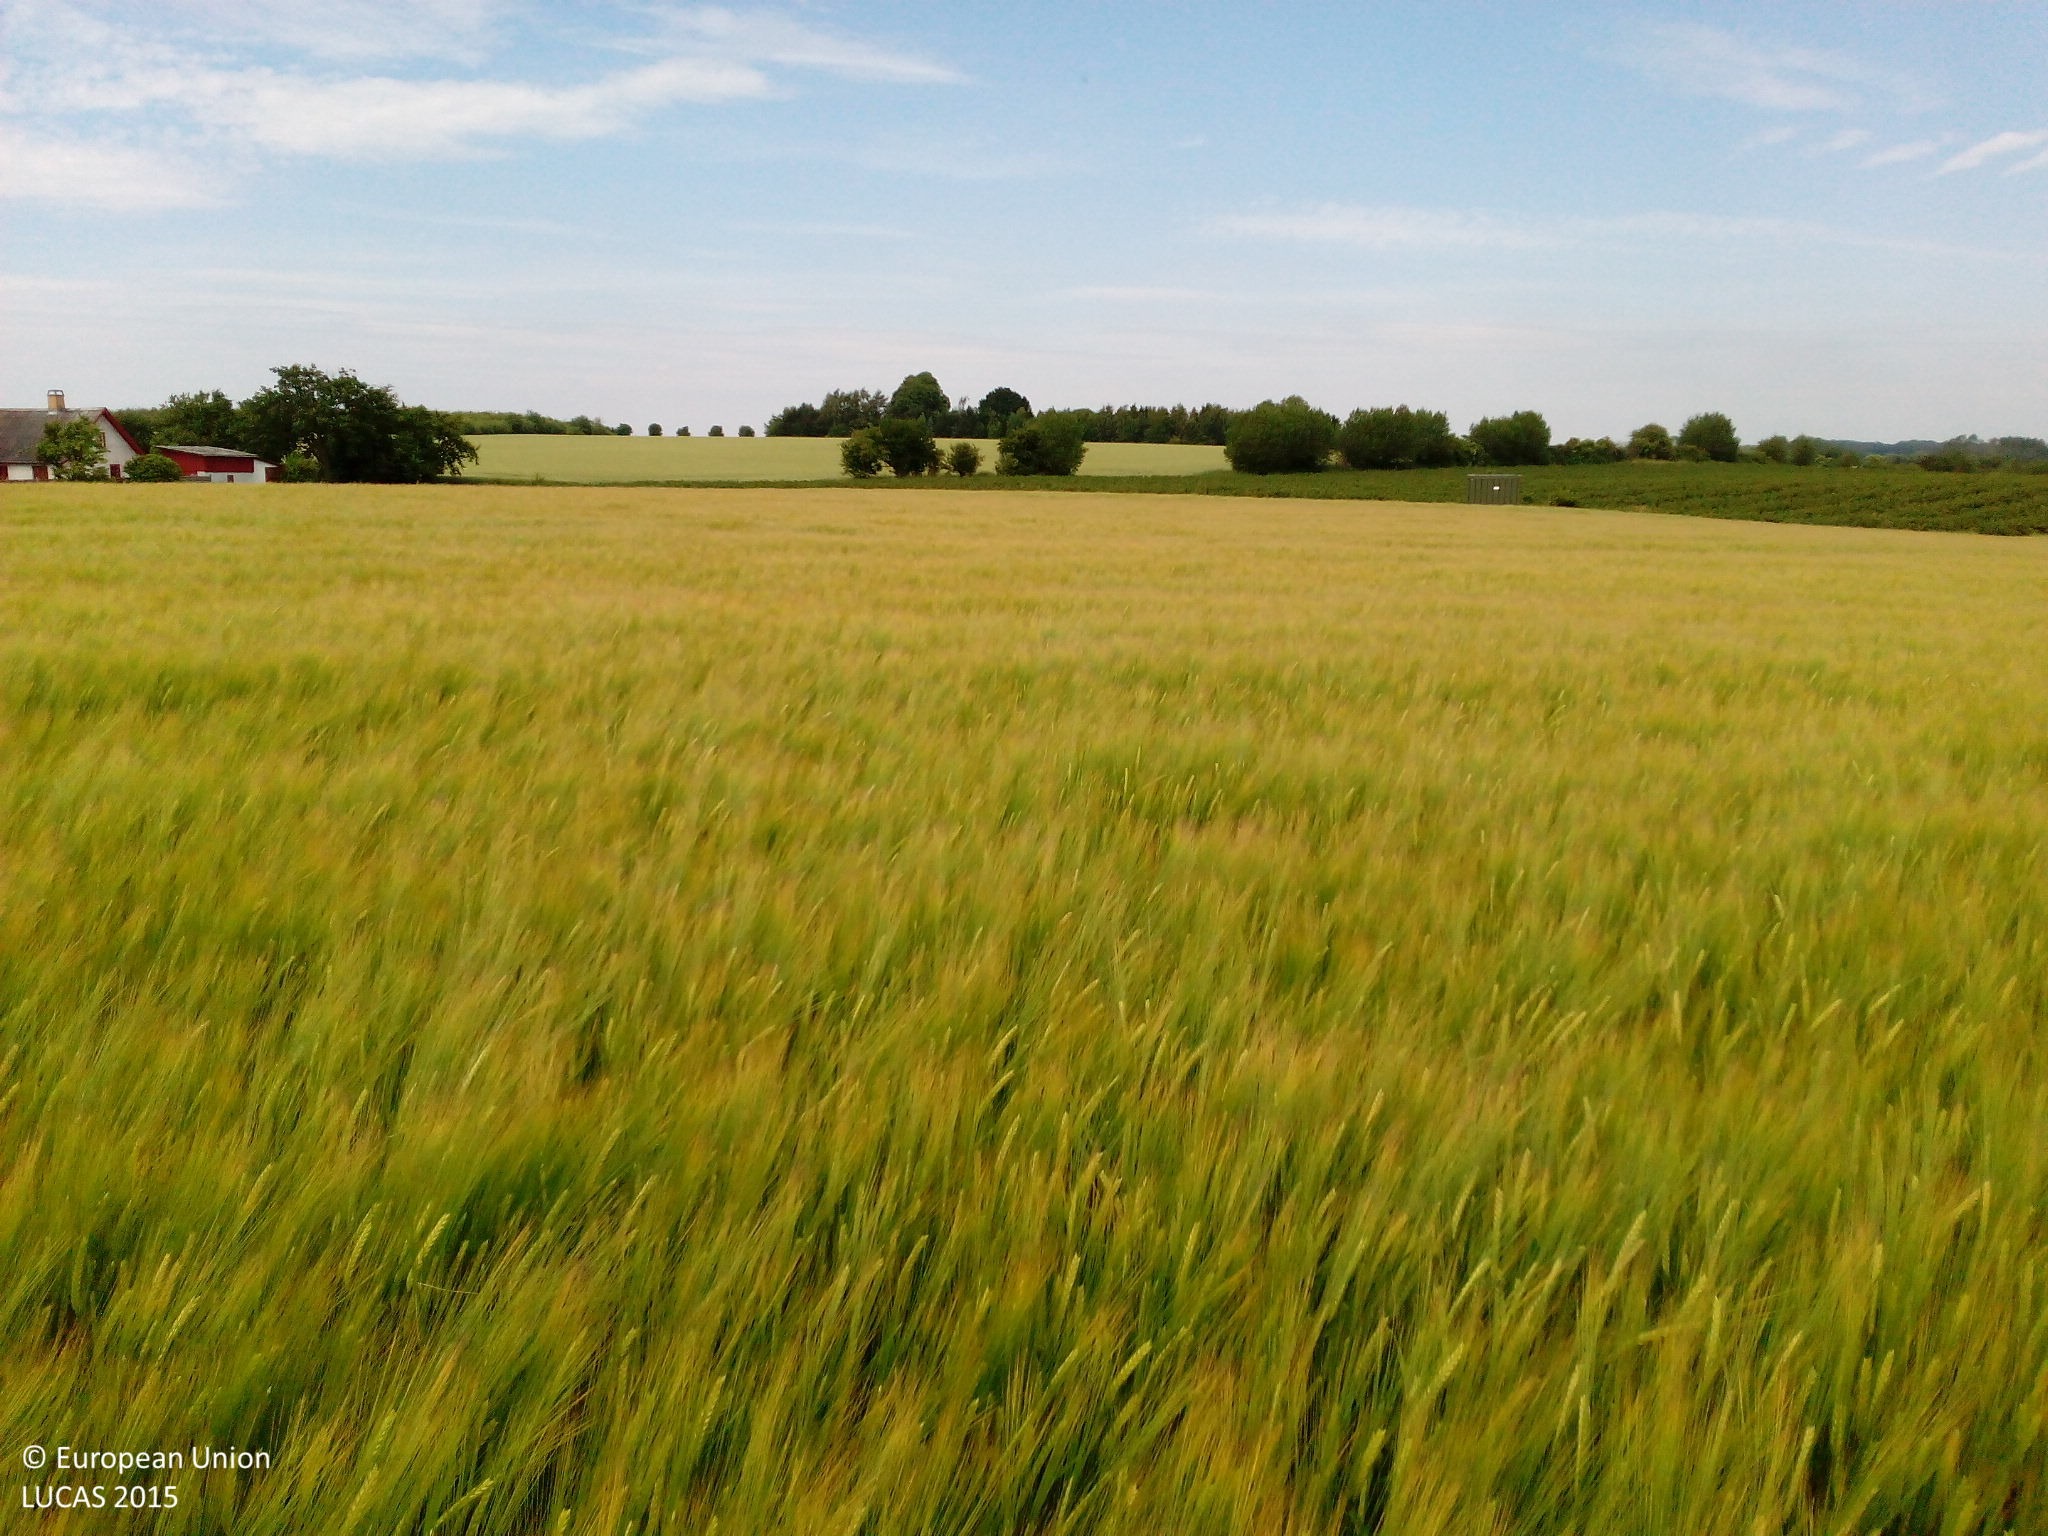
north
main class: Cropland
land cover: Barley
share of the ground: > 75 %
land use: Agriculture (excluding fallow land and kitchen gardens)
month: July
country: DK
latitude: 55.2423
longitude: 11.6501
